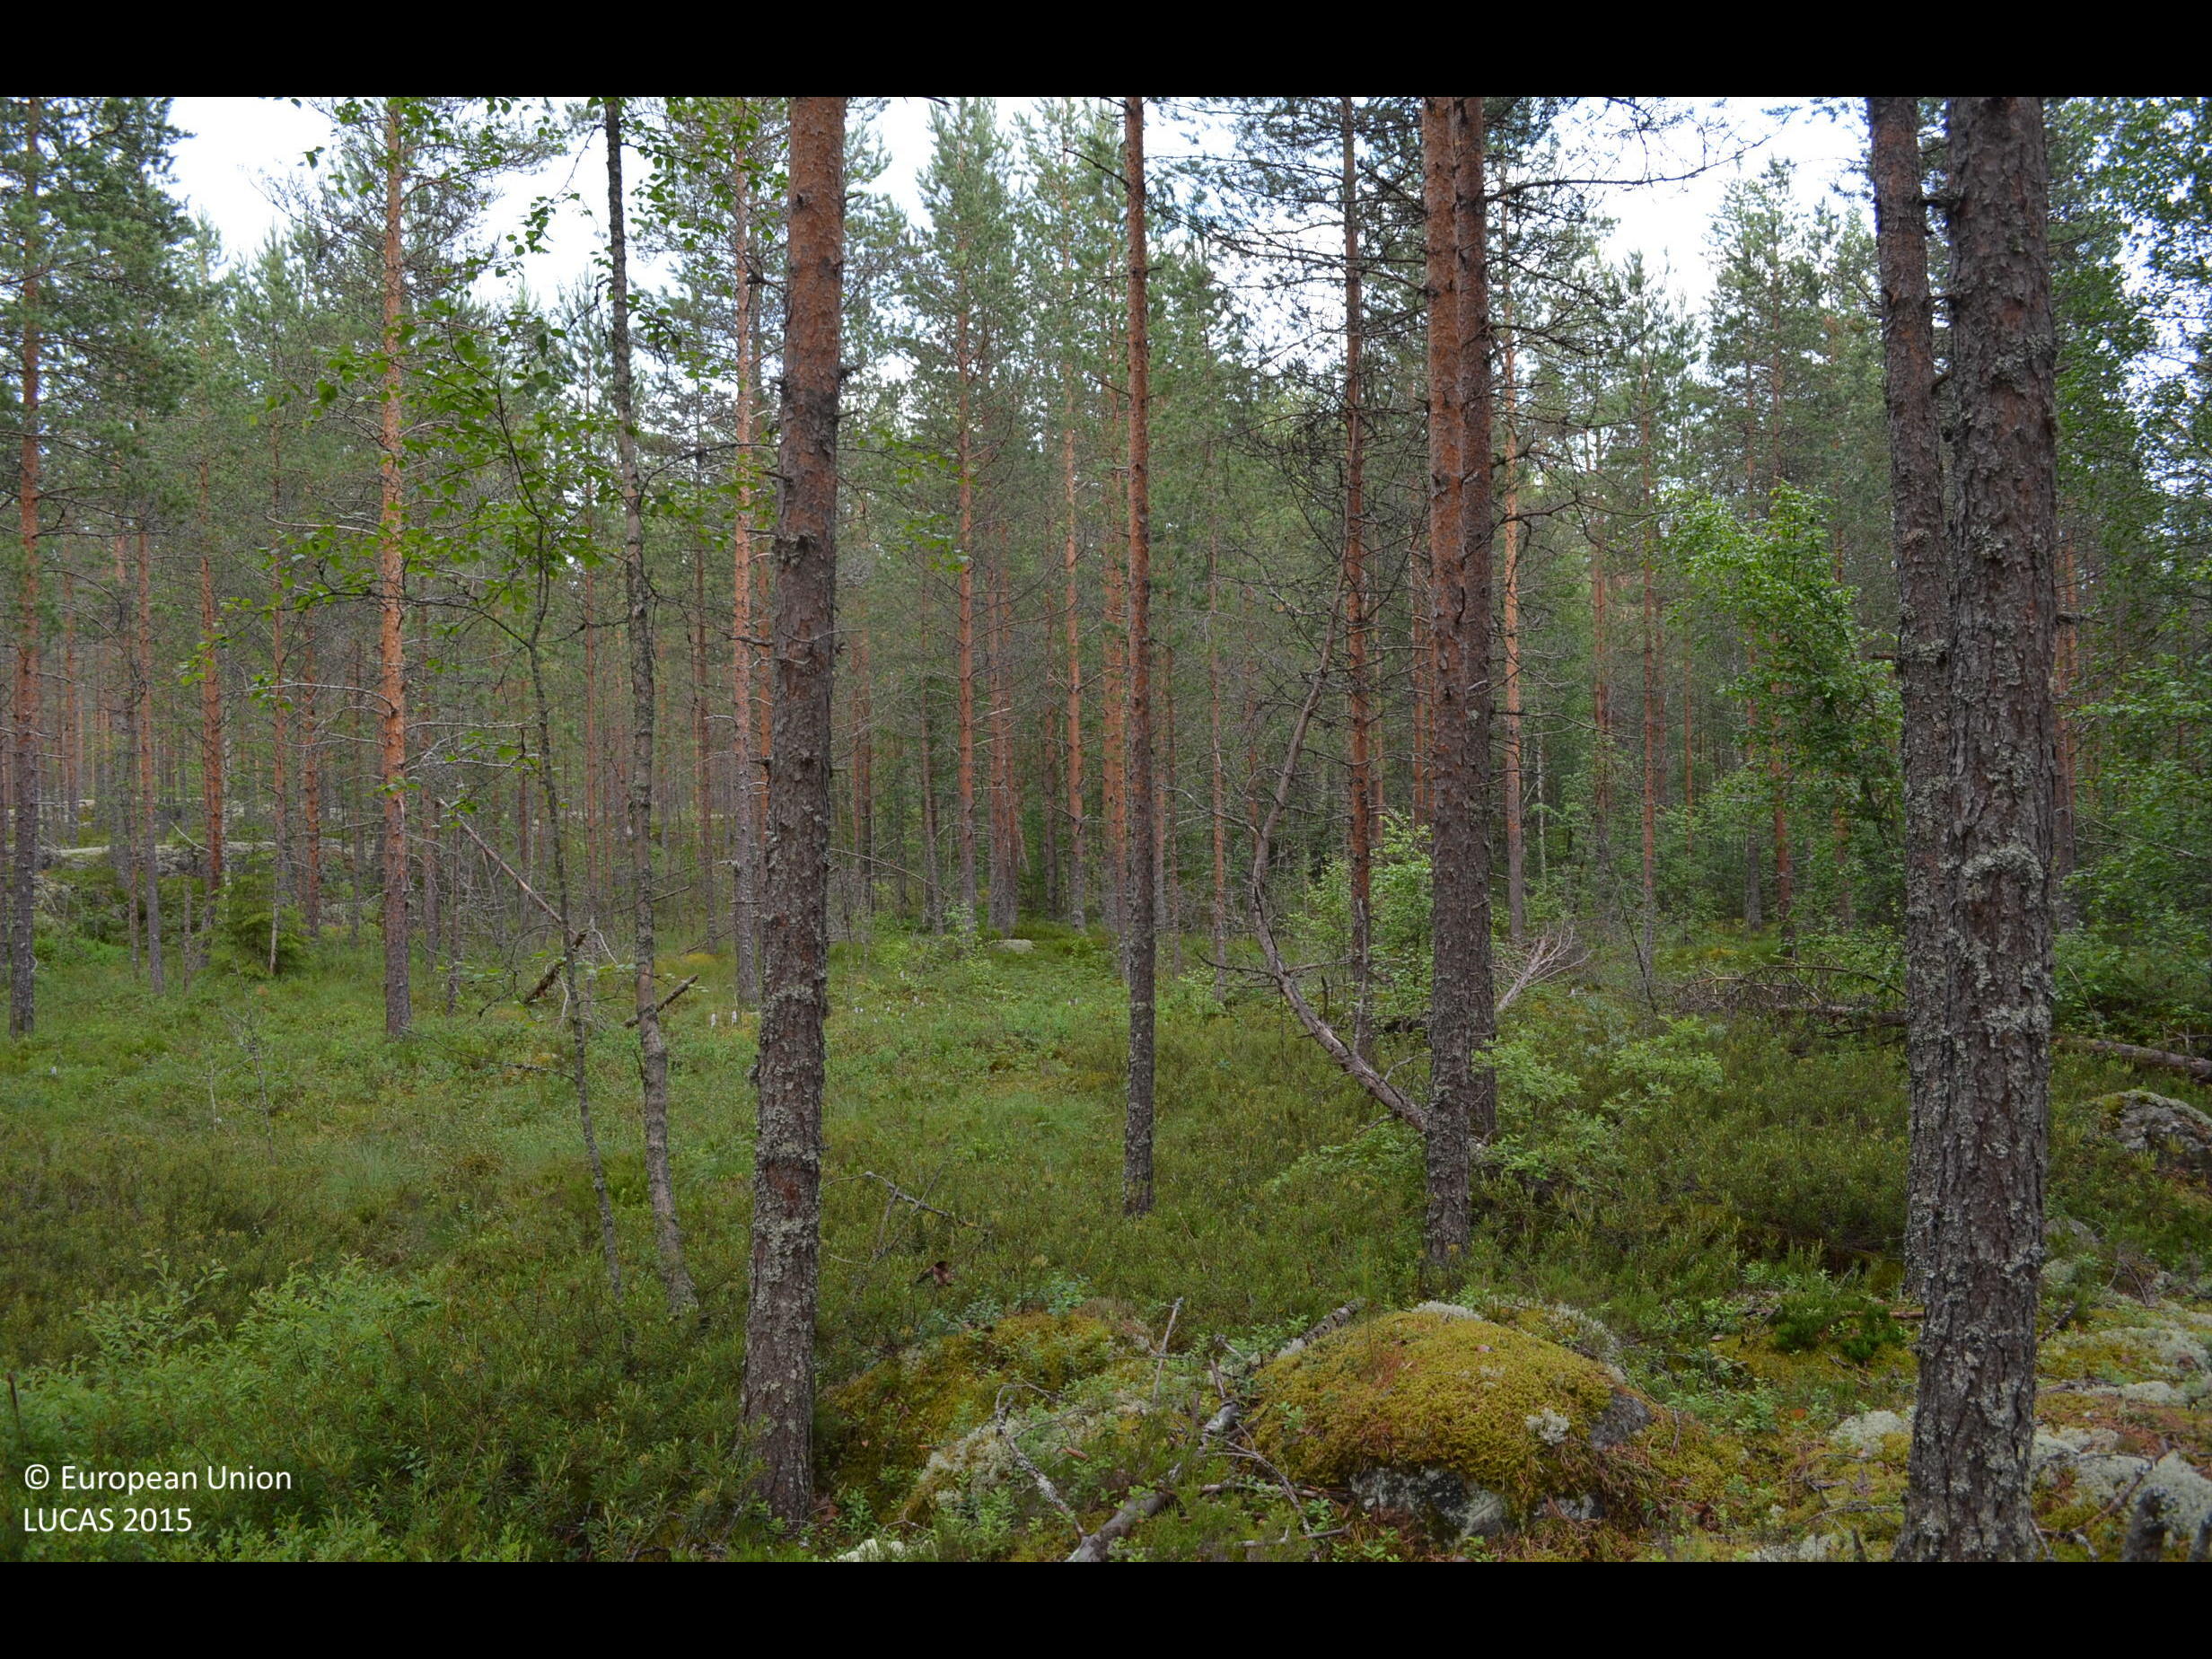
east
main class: Woodland
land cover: Pine dominated coniferous woodland
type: boreal forest
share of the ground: 50 - 75 %
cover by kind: coniferous forest trees 60 %, shrubs 20 %, lichens and mosses 20 %
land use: Forestry
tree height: > 5 m
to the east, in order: Pine dominated coniferous woodland; Pine dominated mixed woodland; Pine dominated coniferous woodland; Ditches and canals; Grass margins; Paved roads, cycling and walking lanes; Grass margins; Ditches and canals; Pine dominated coniferous woodland
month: July
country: FI
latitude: 62.2085
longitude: 23.4340
